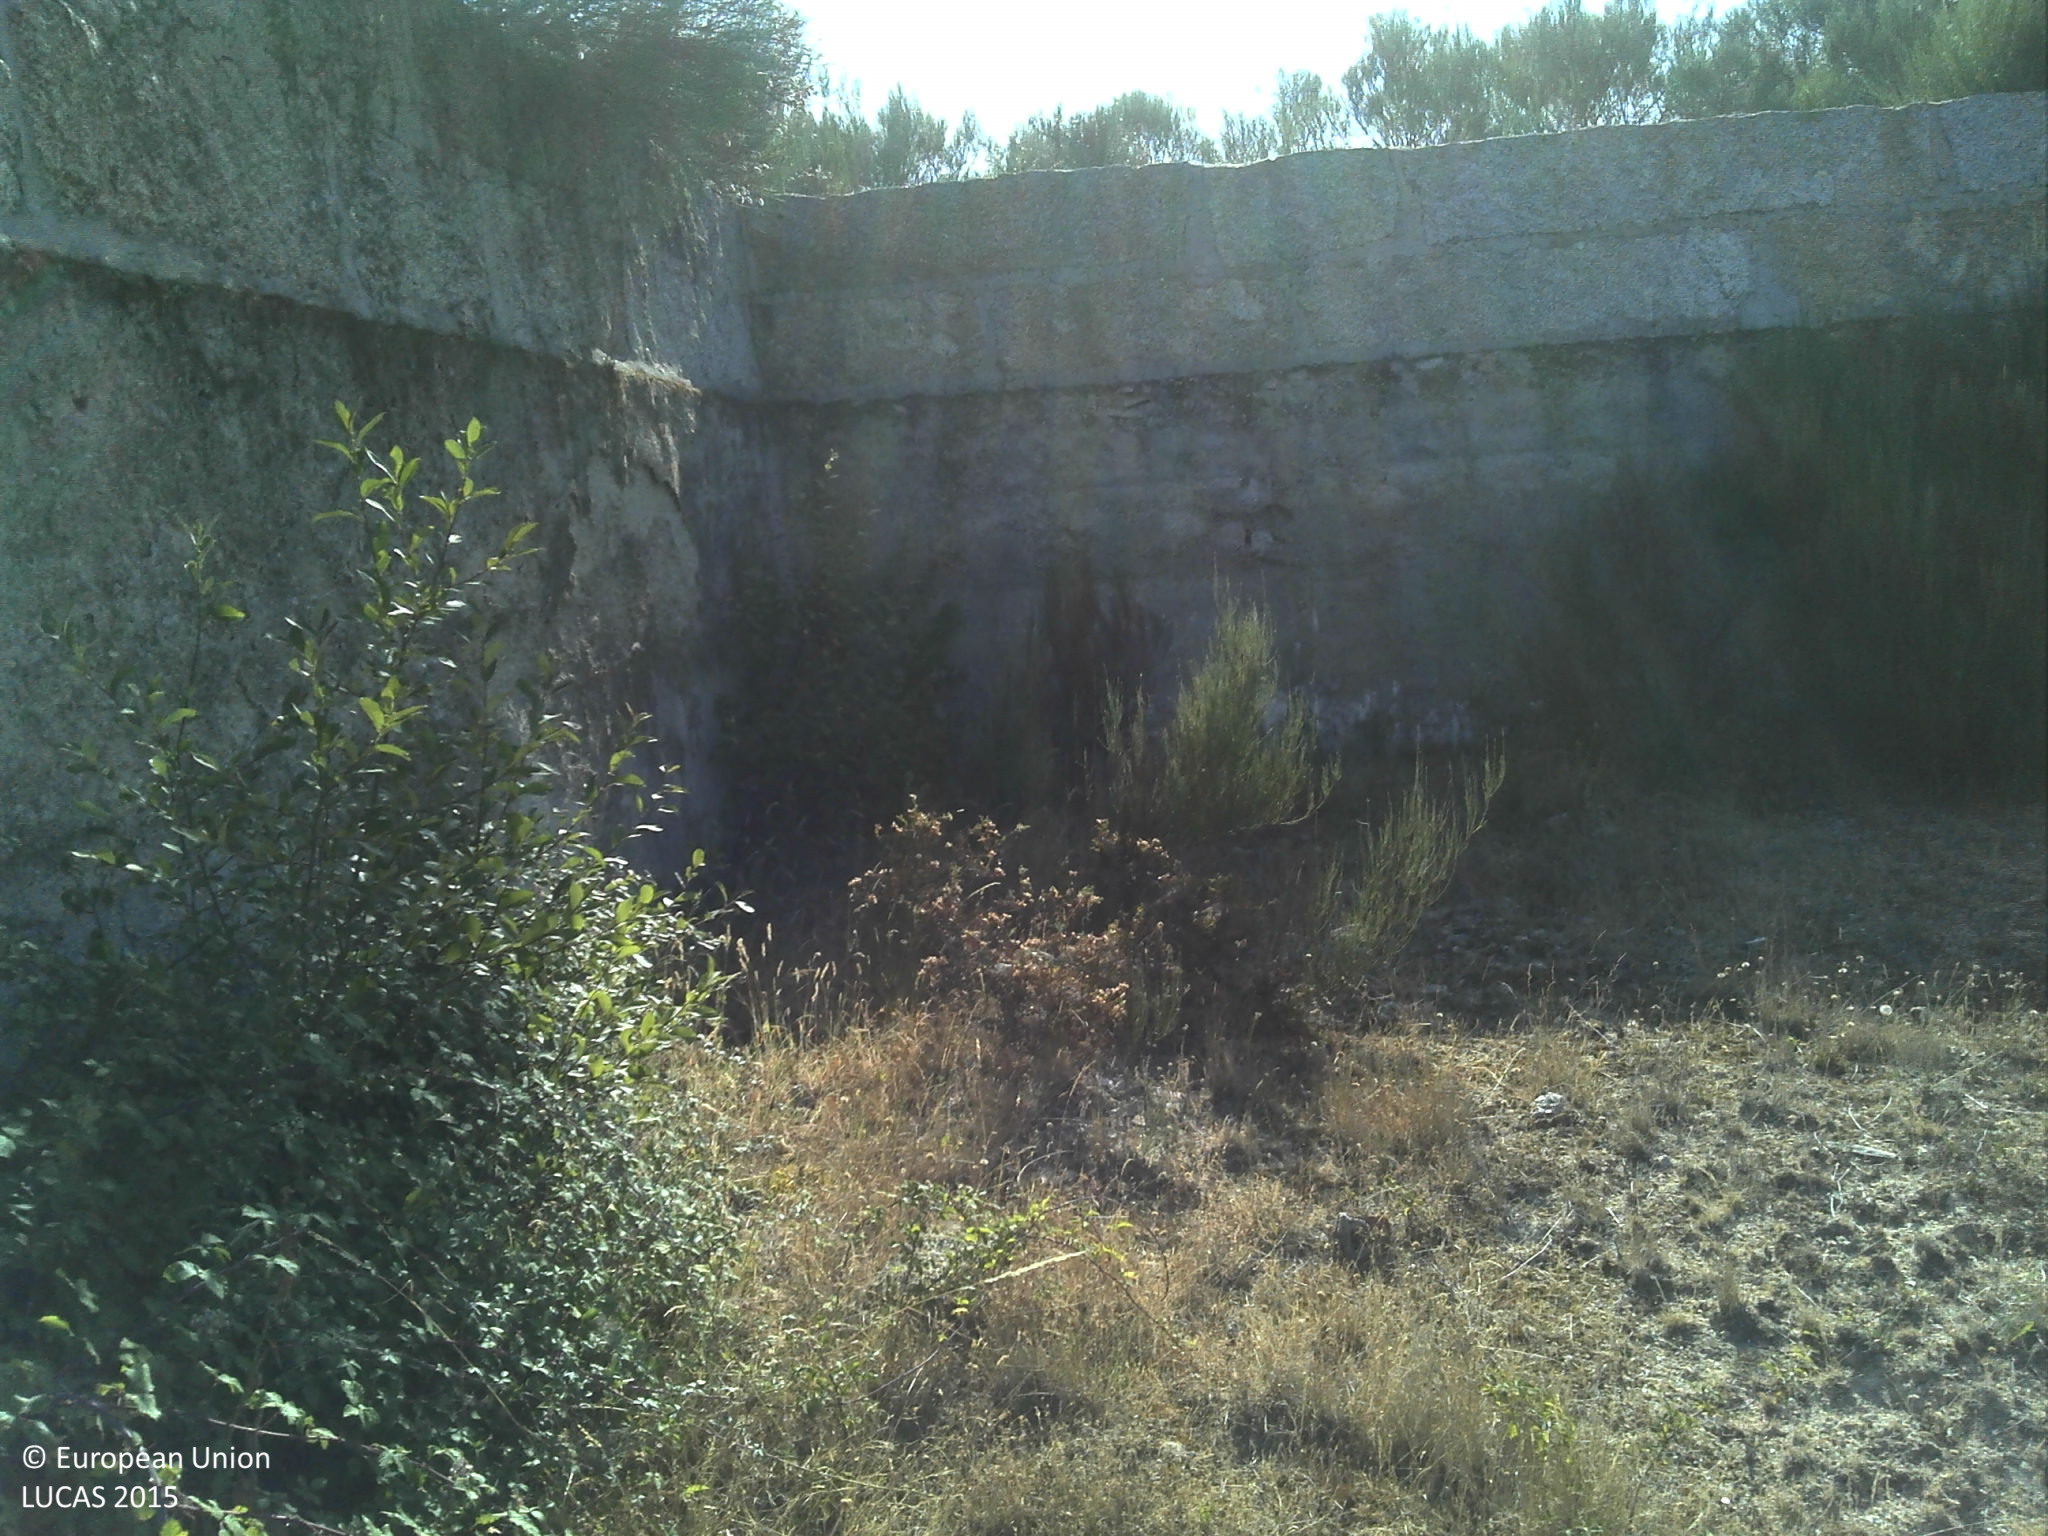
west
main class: Grassland
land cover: Grassland without tree/shrub cover
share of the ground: > 75 %
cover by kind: herbaceous plants 75 %, unconsolidated bare surface 20 %, shrubs 5 %
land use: Agriculture (excluding fallow land and kitchen gardens)
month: July
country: PT
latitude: 41.7135
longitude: -7.7697
